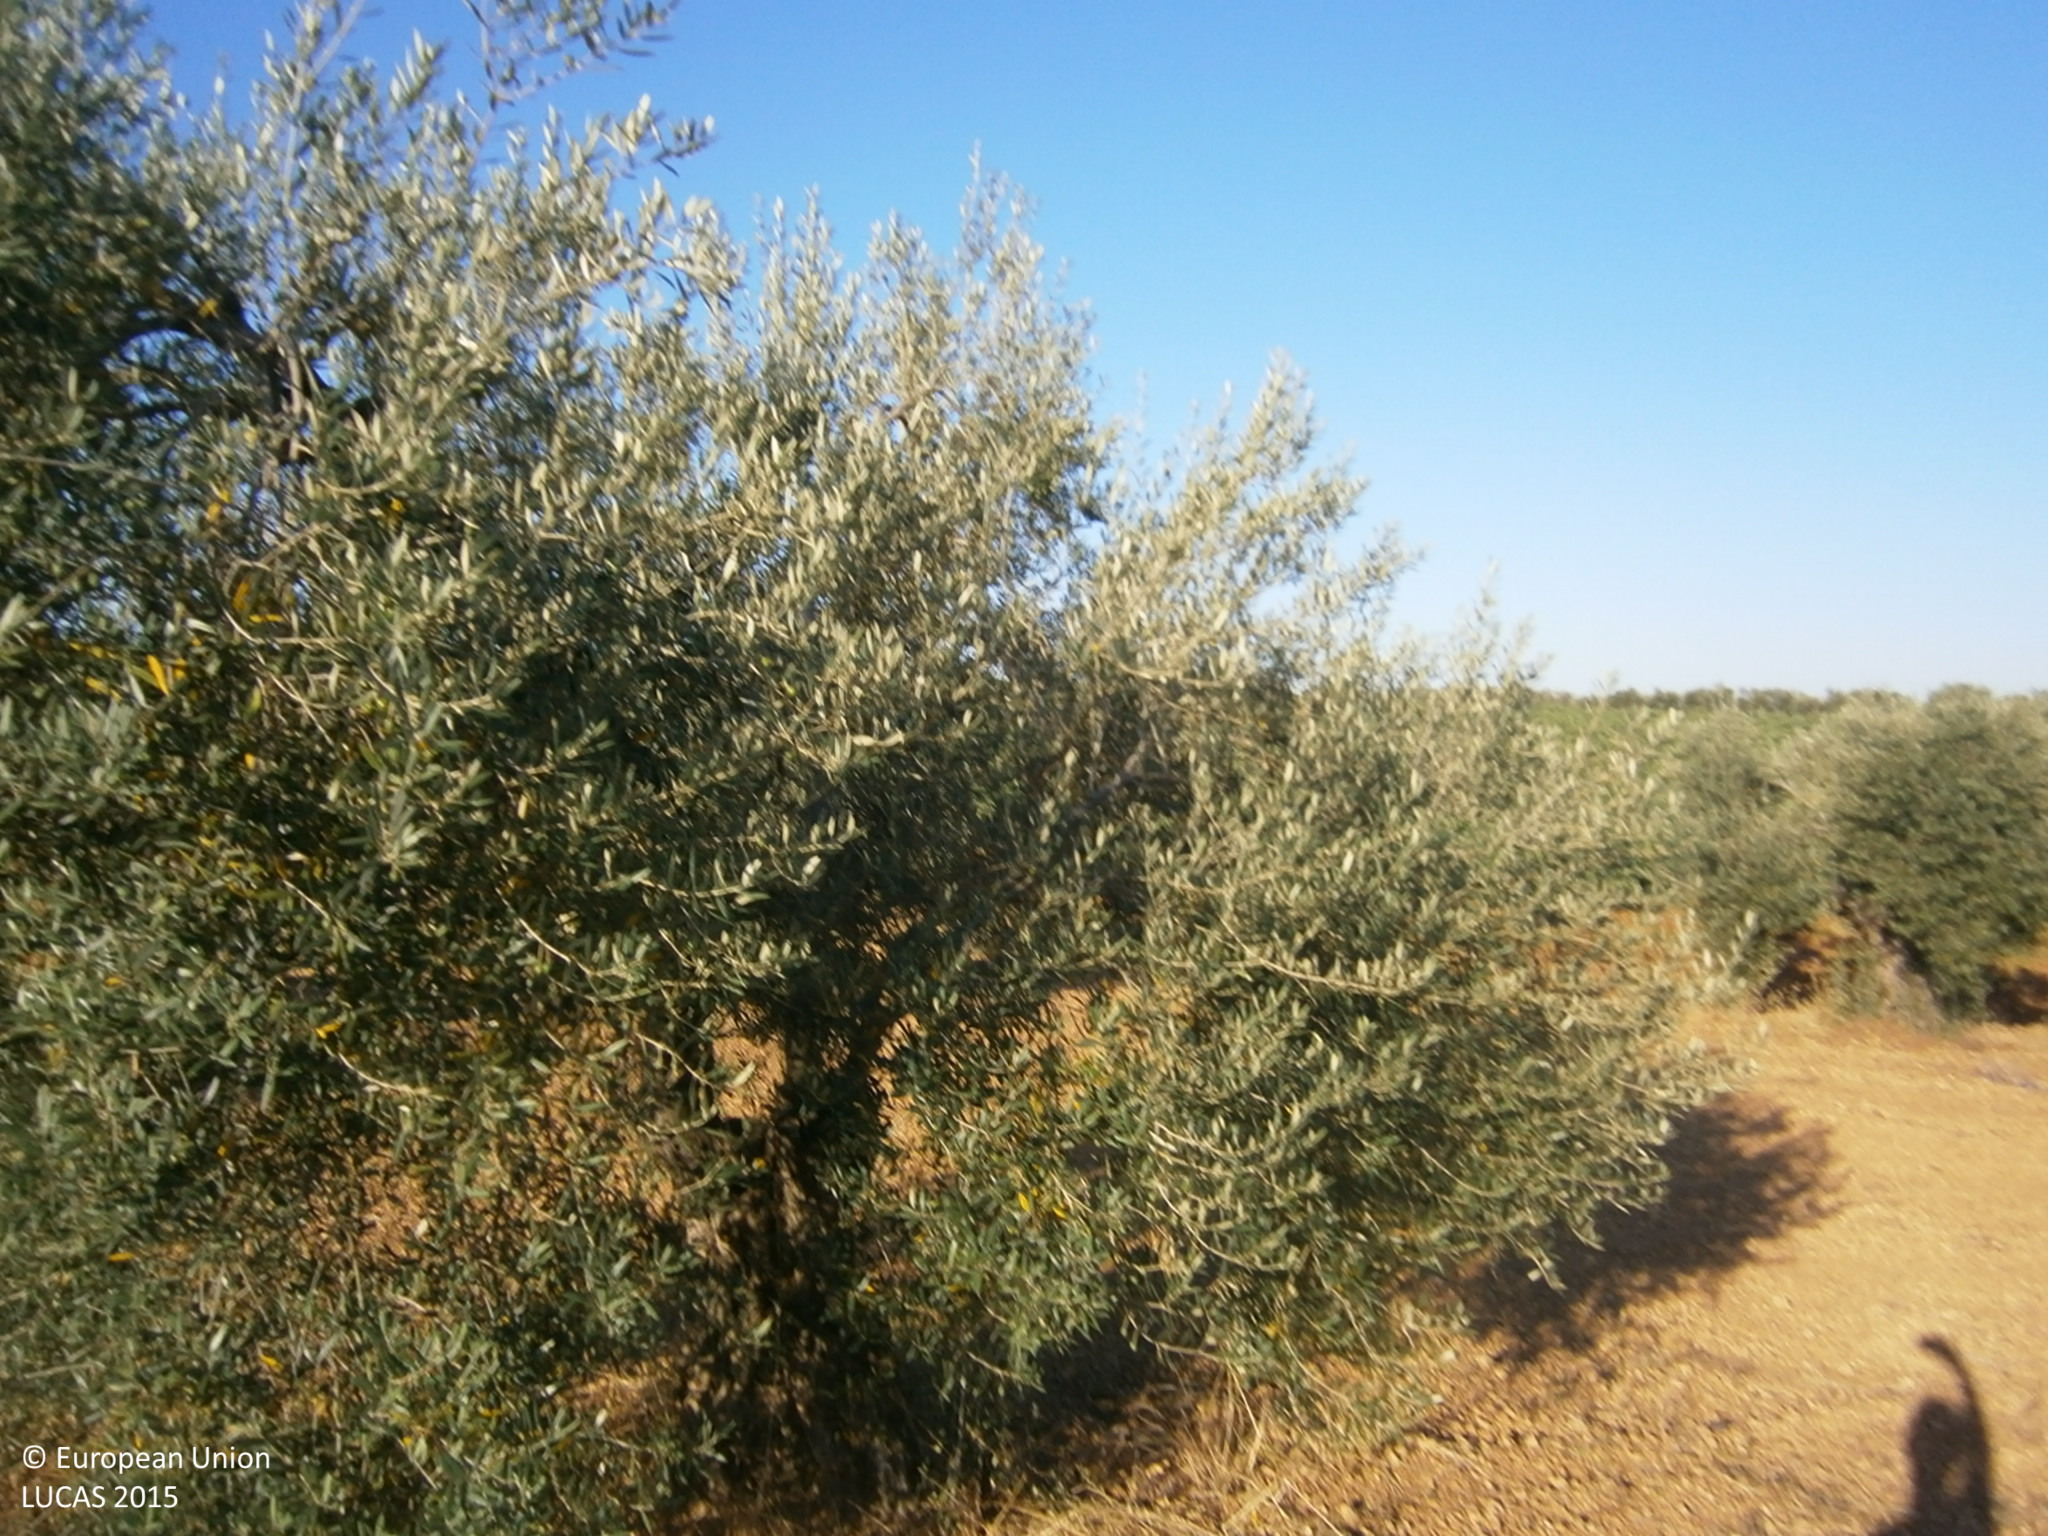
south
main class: Cropland
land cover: Olive groves
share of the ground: 10 - 25 %
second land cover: Other bare soil
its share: > 75 %
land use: Agriculture (excluding fallow land and kitchen gardens)
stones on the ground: 10 - 25 %
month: June
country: ES
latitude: 38.7135
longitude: -6.7023
